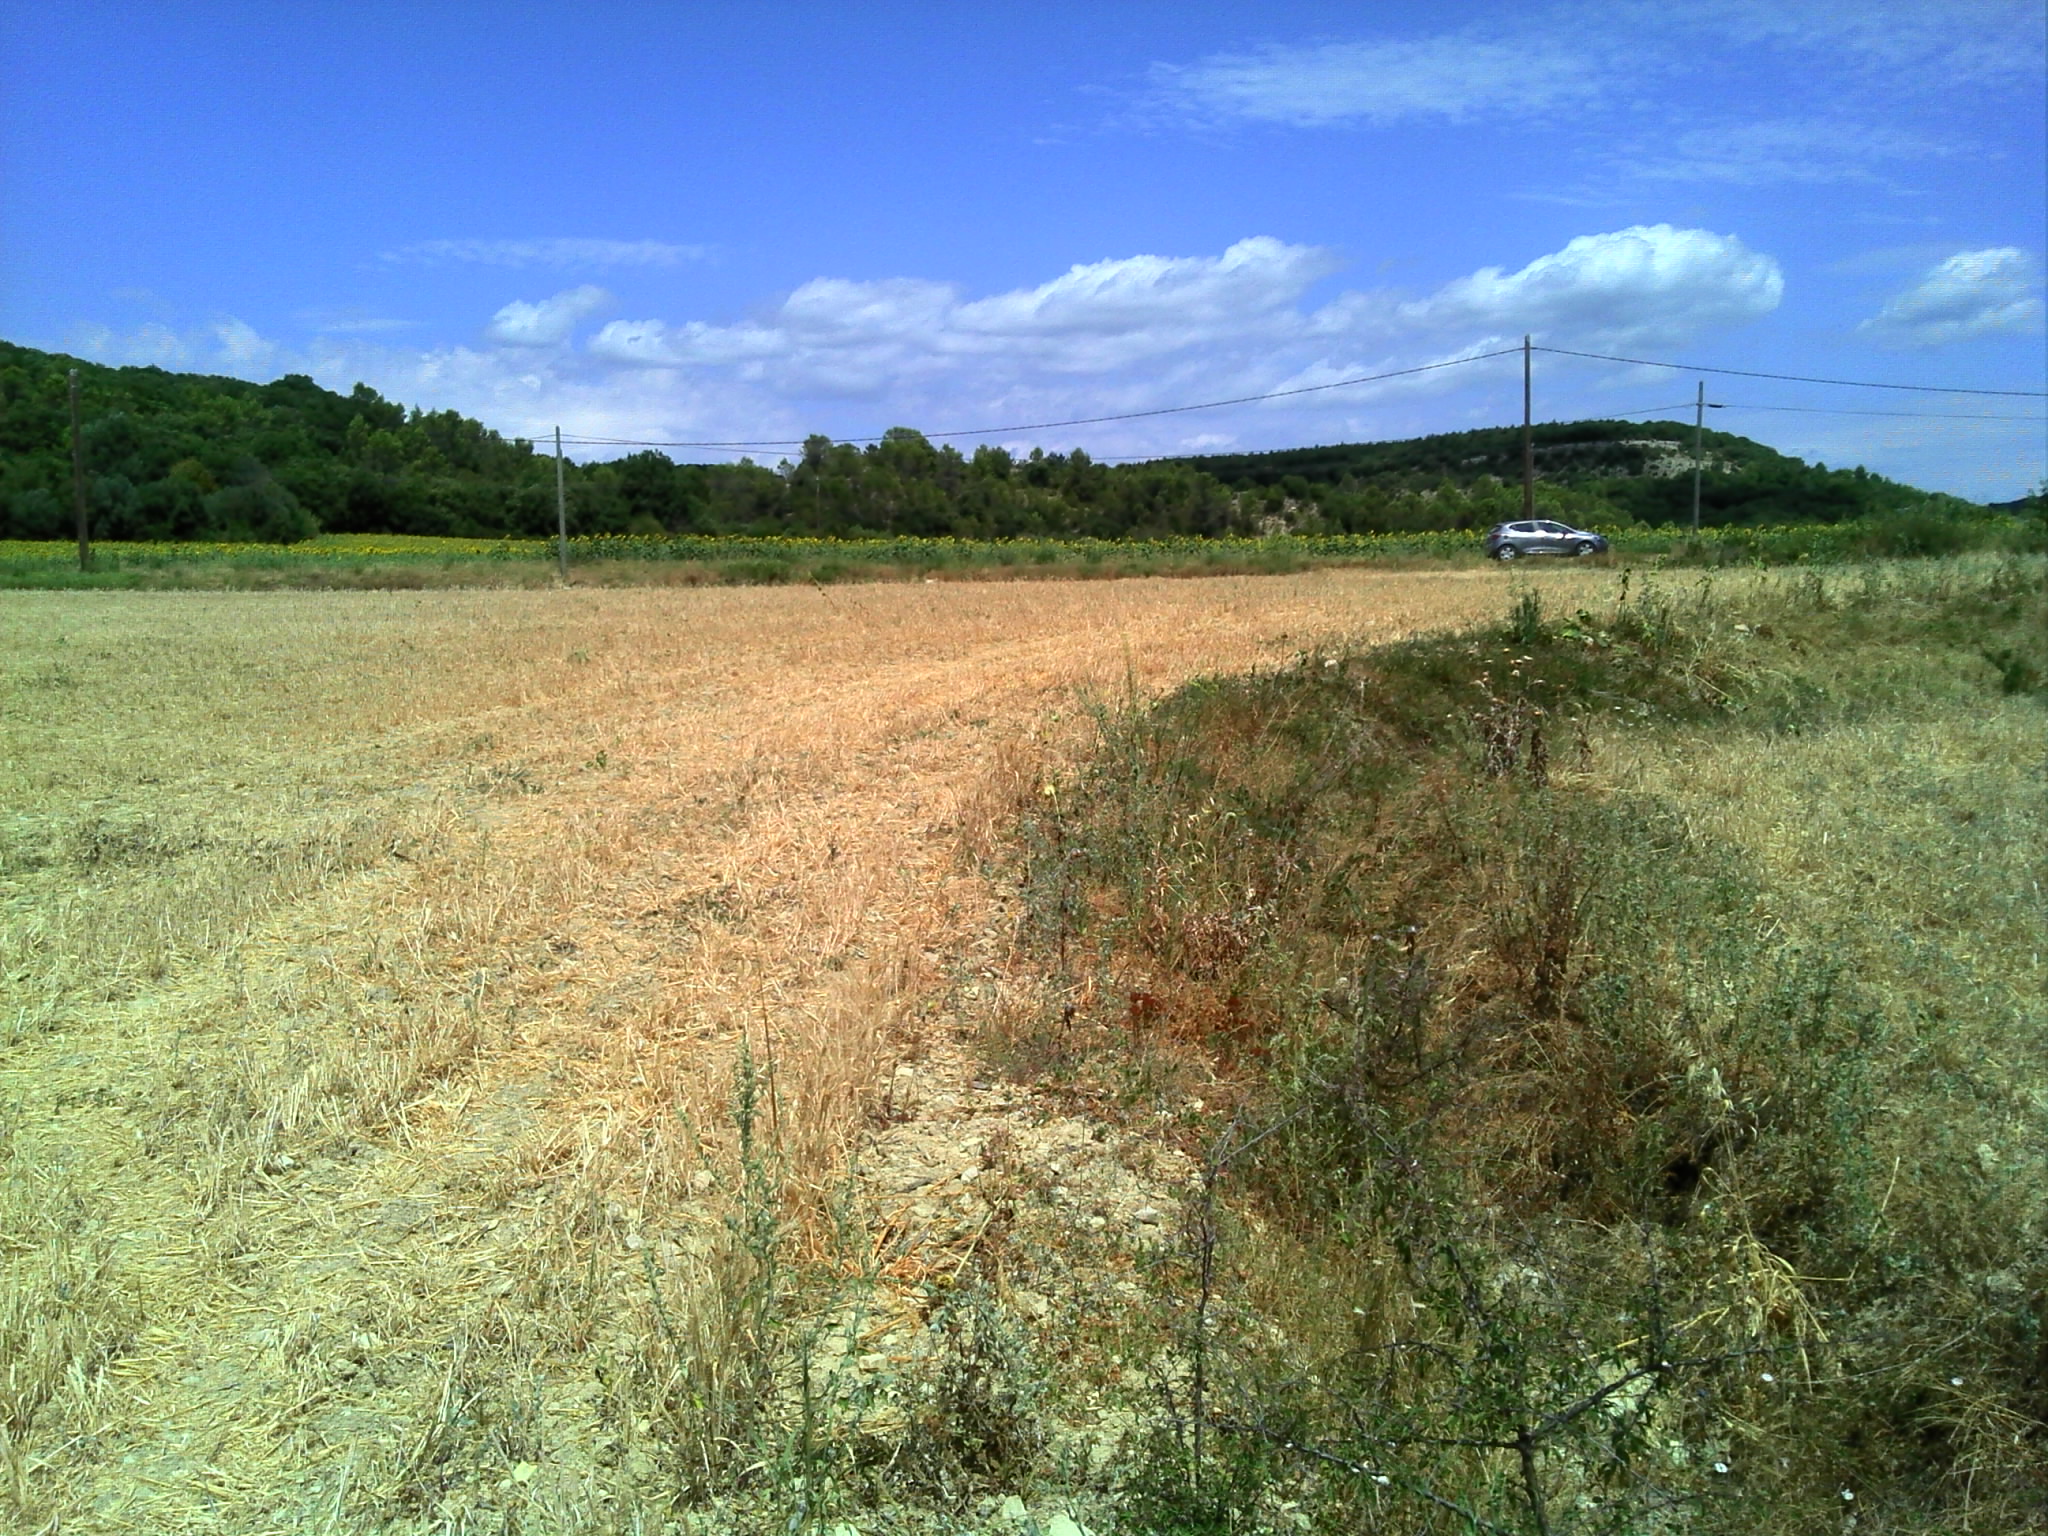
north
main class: Cropland
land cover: Durum wheat
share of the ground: 10 - 25 %
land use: Agriculture (excluding fallow land and kitchen gardens)
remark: Harvested field
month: July
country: FR
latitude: 44.0882
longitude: 4.3502
